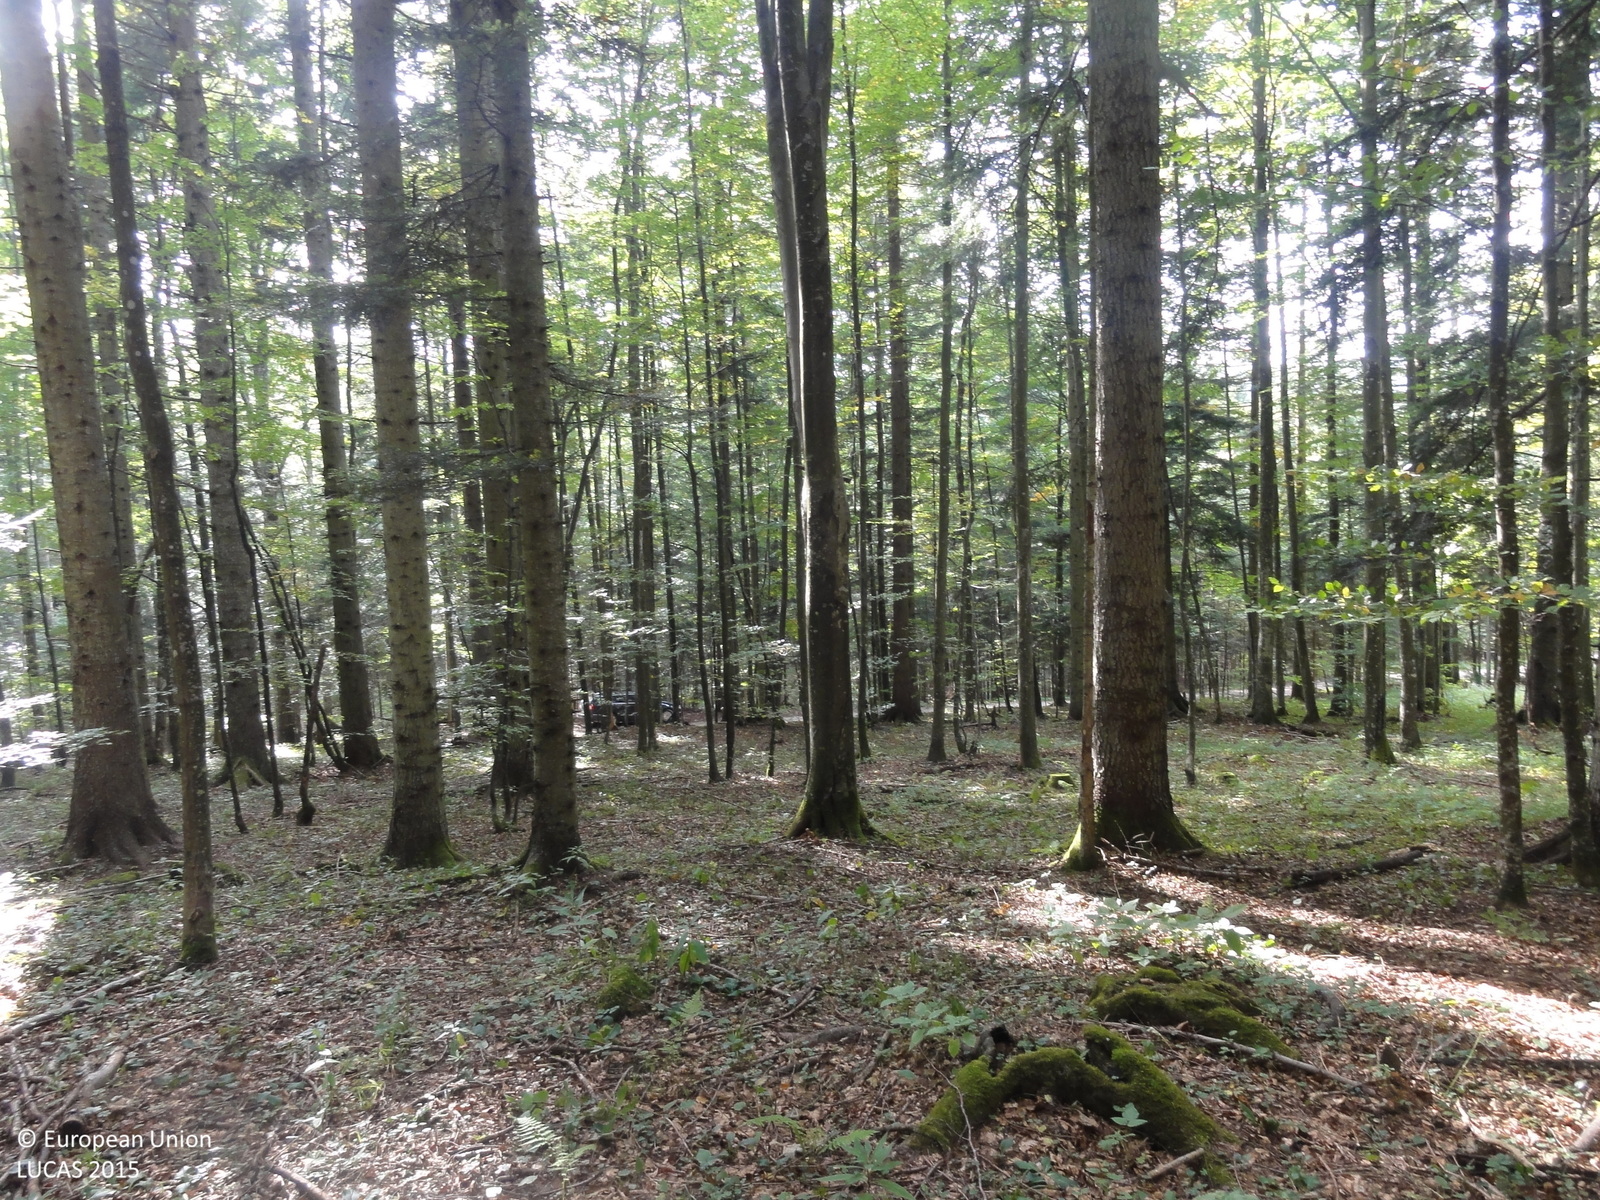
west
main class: Woodland
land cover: Spruce dominated mixed woodland
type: mountainous beech forest
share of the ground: > 75 %
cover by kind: broadleaved forest trees 60 %, coniferous forest trees 40 %
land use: Forestry
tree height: > 5 m
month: September
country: SI
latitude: 45.6165
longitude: 15.0872
